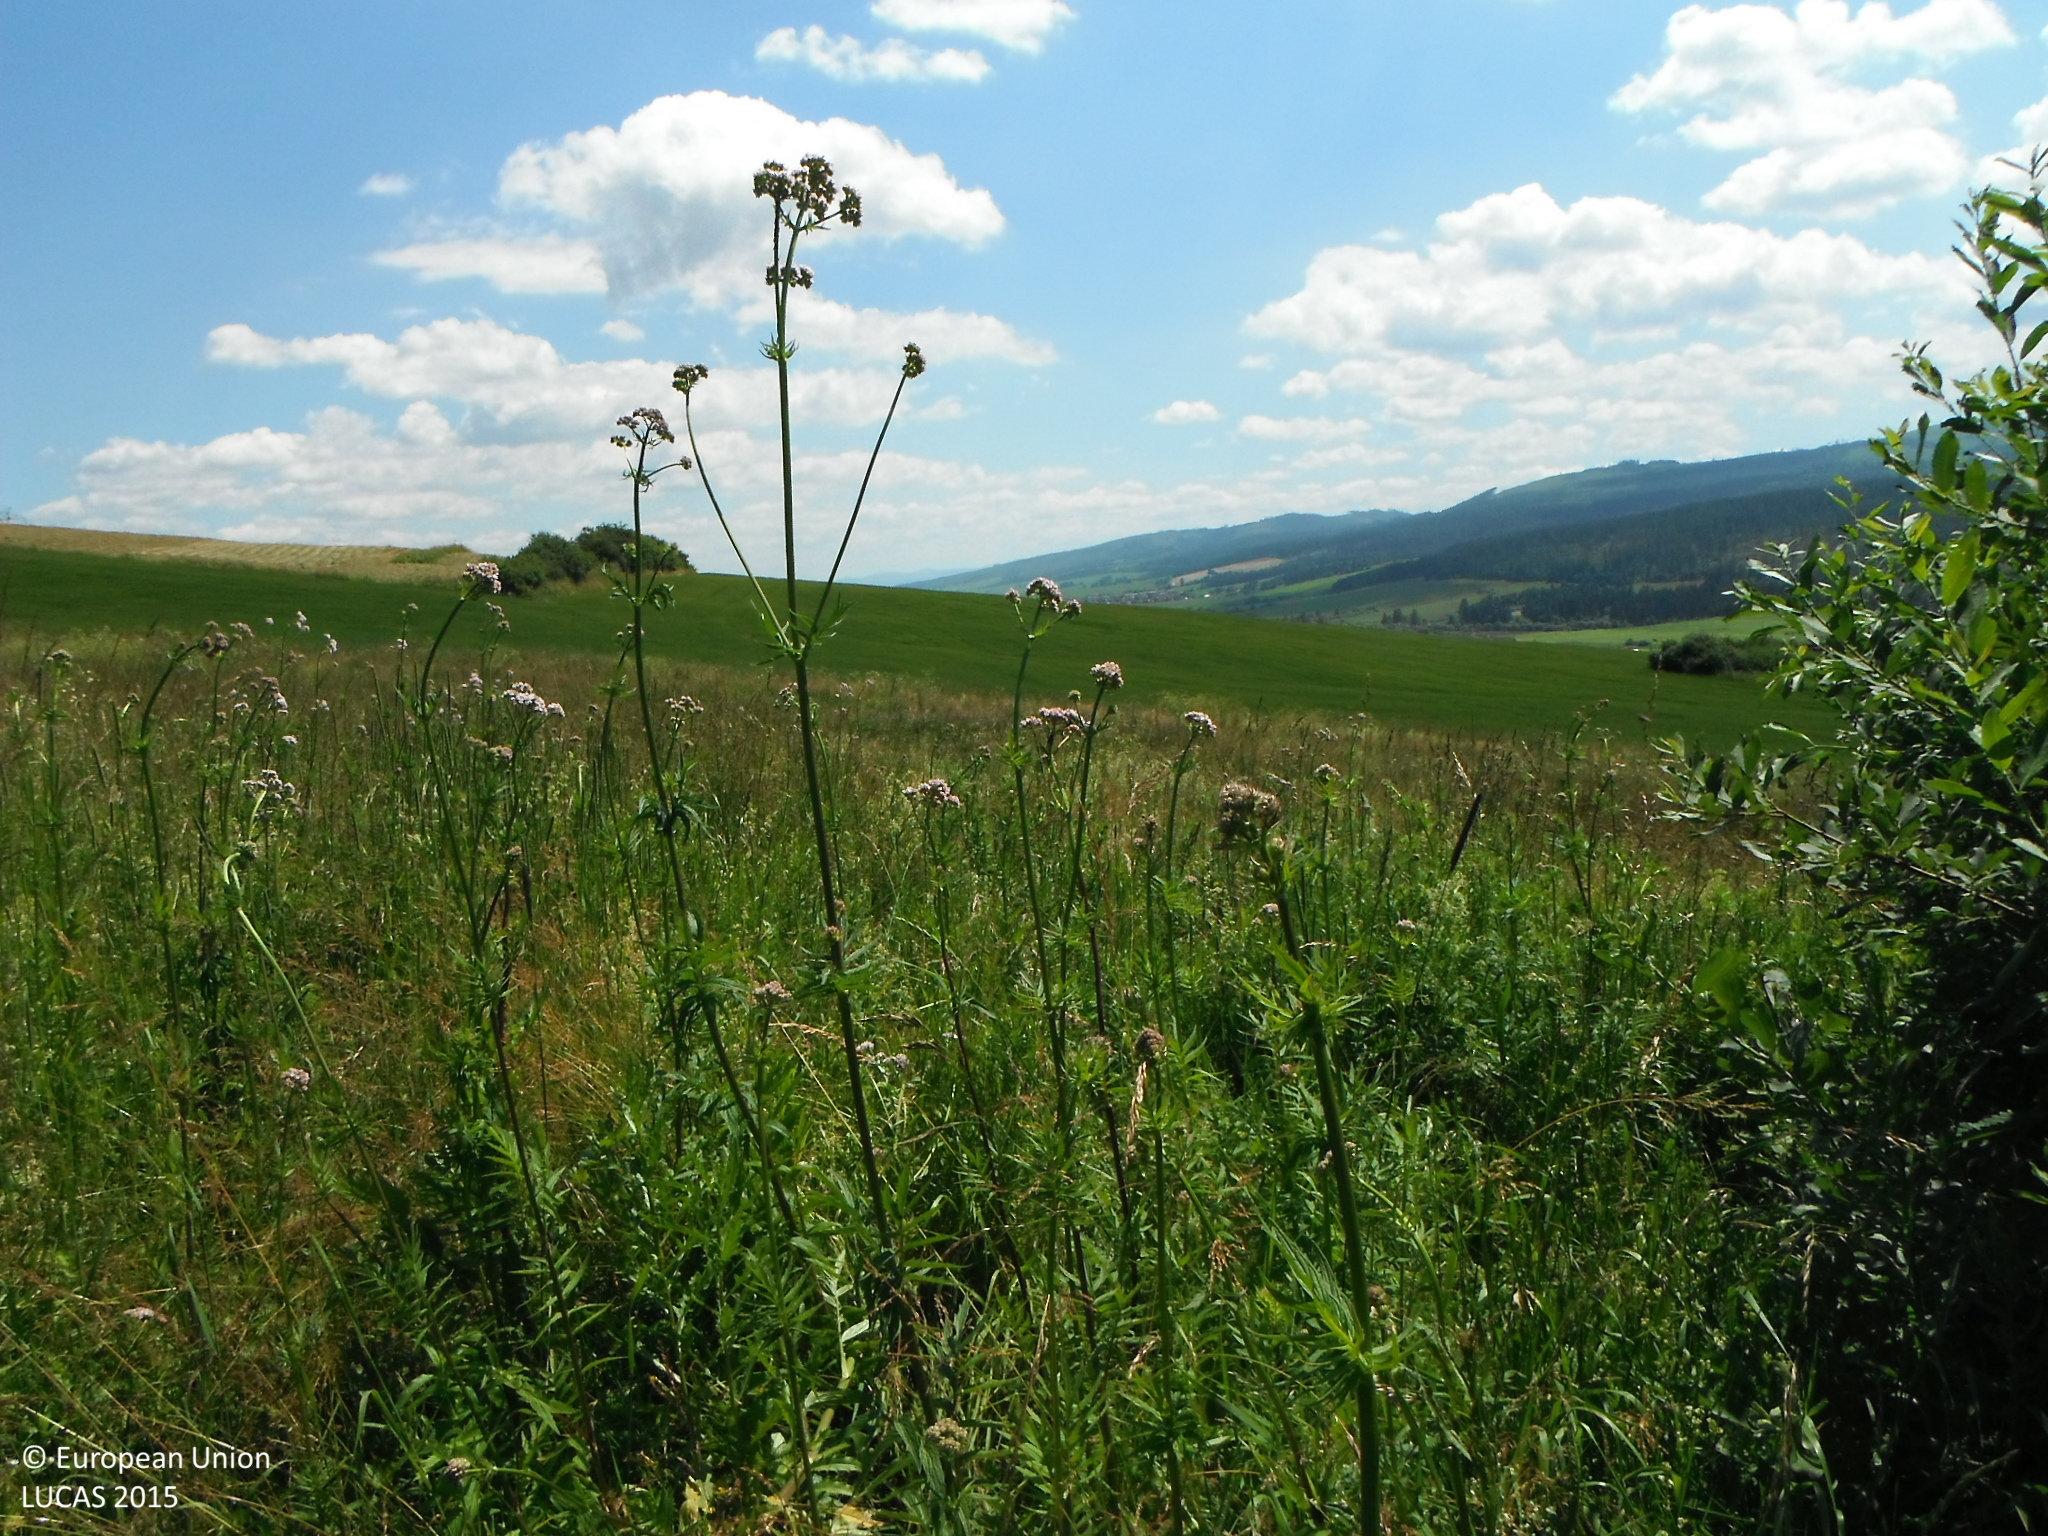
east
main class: Shrubland
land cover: Shrubland without tree cover
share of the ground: > 75 %
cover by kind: shrubs 100 %
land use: Semi-natural and natural areas not in use
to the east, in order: Shrubland without tree cover; Spontaneously vegetated surfaces; Barley; Grassland without tree/shrub cover
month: July
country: SK
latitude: 49.0014
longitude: 20.1889
